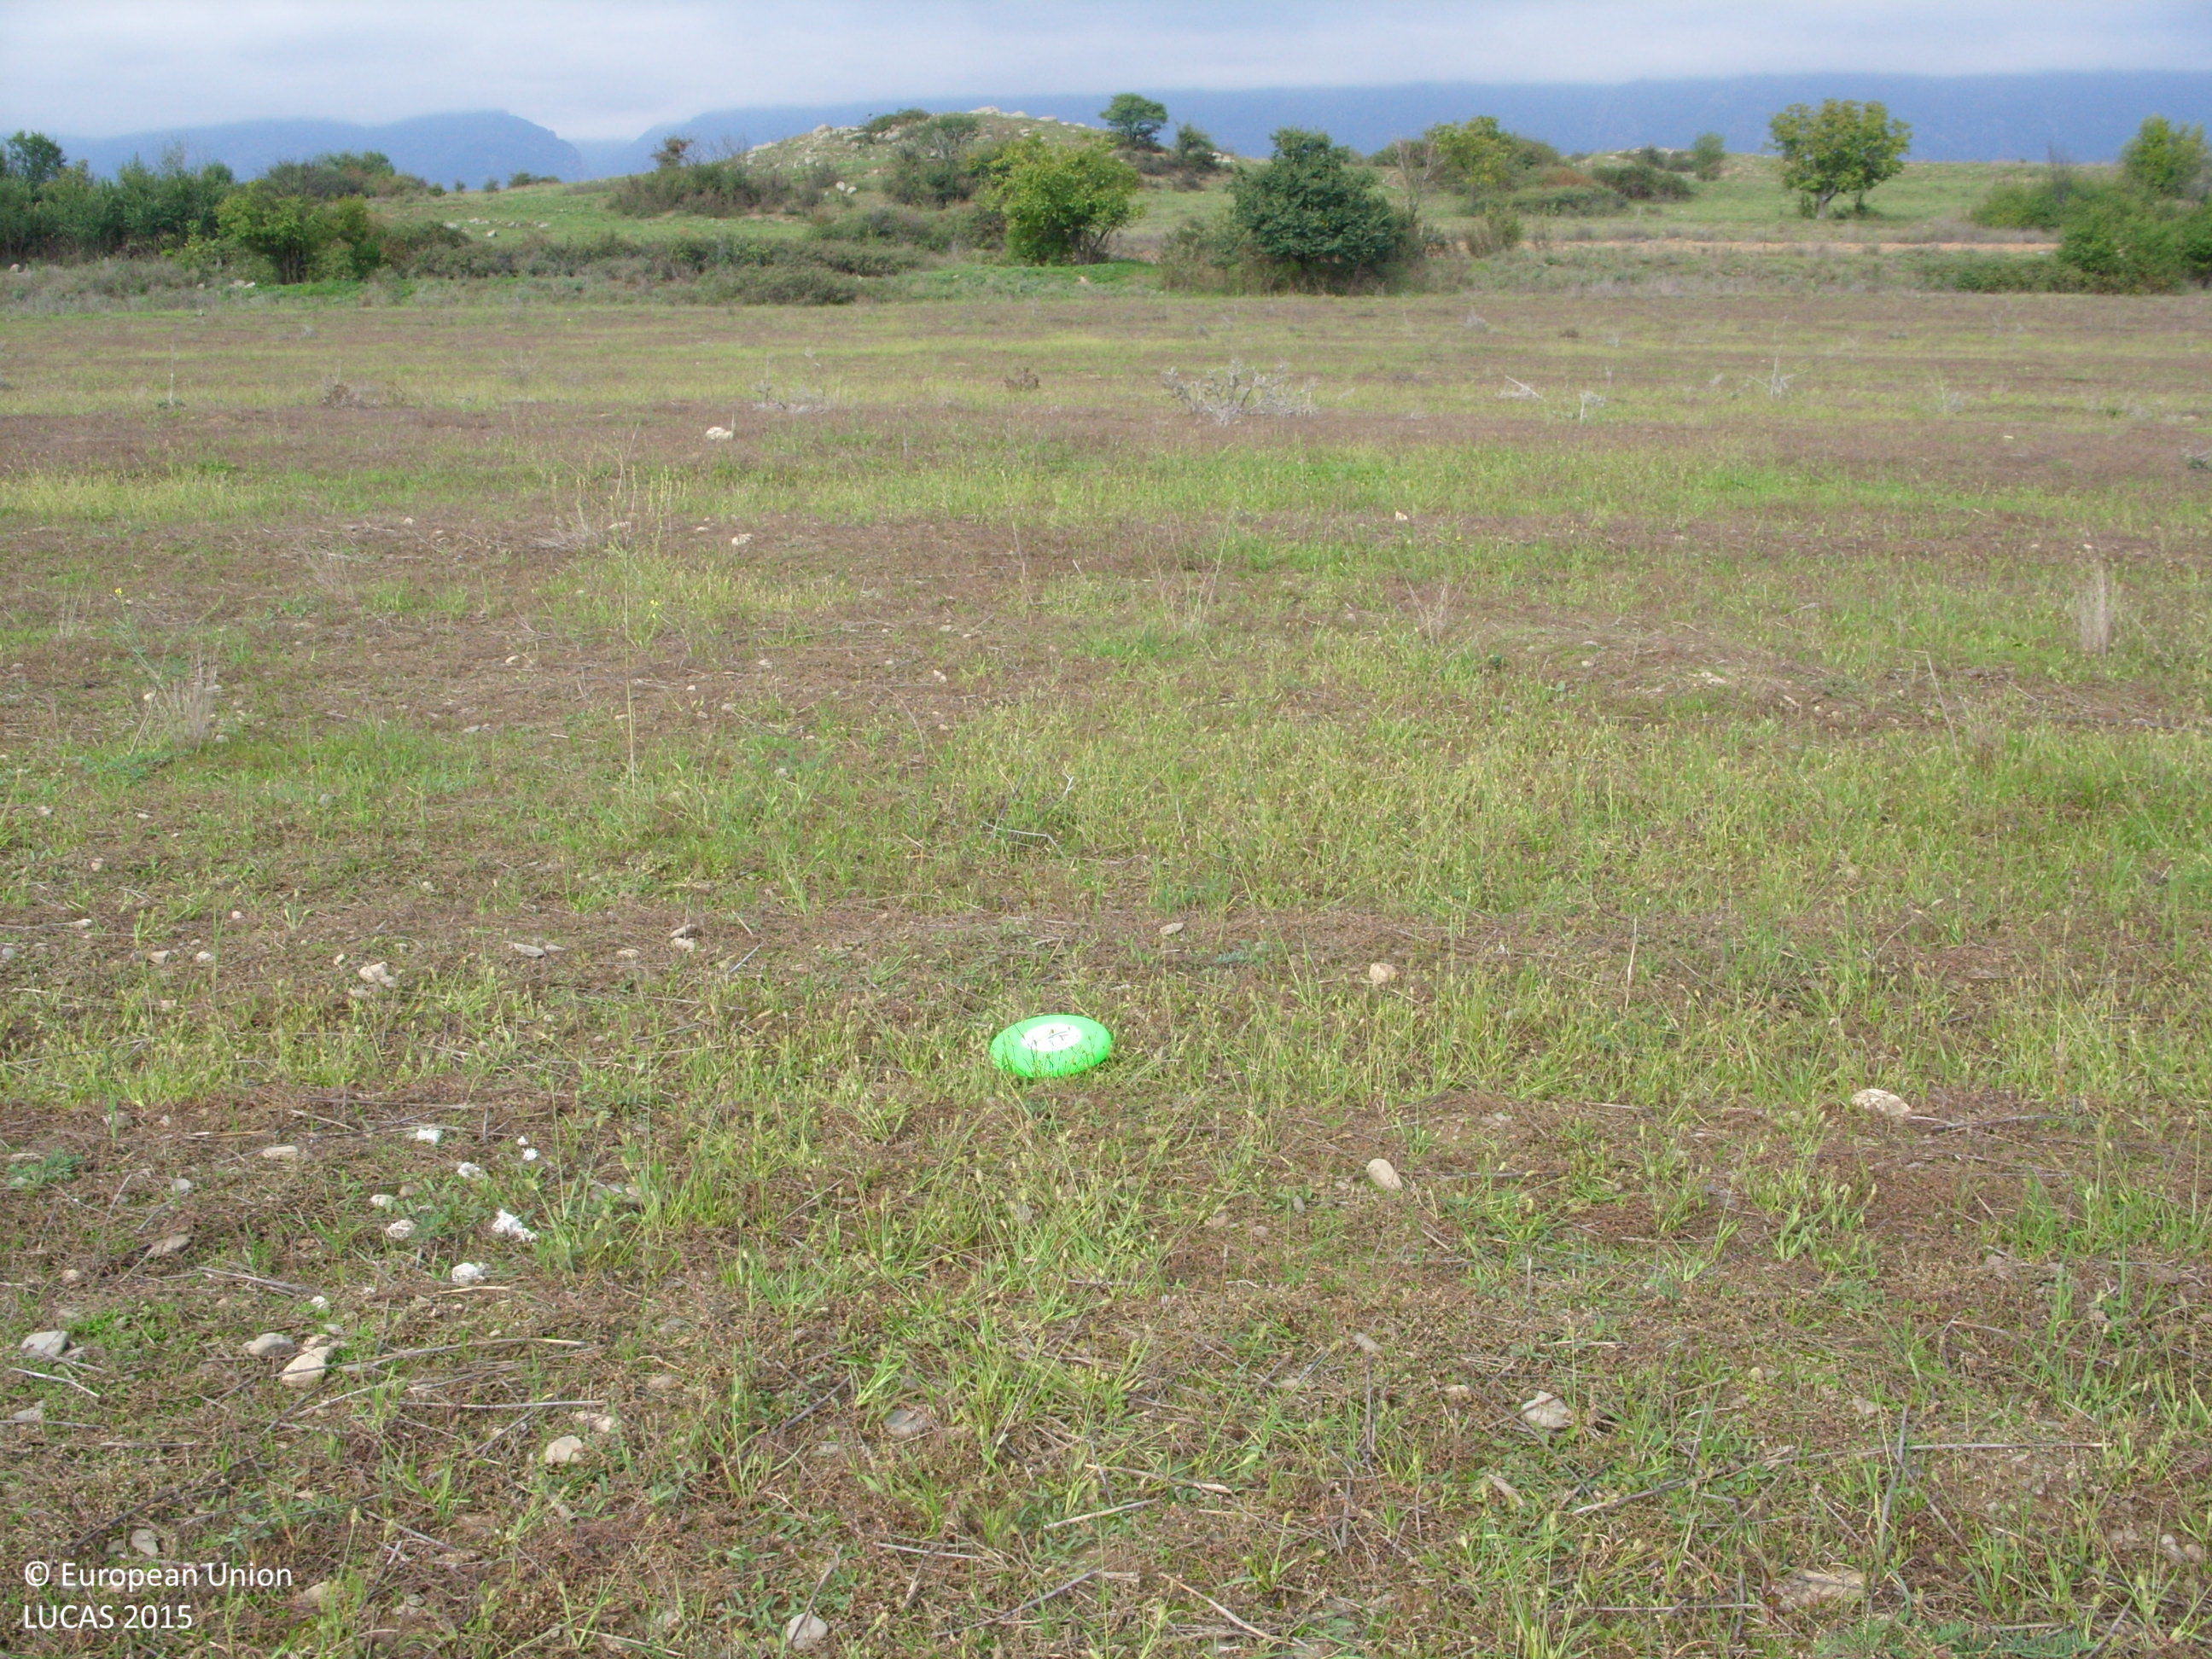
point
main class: Grassland
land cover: Spontaneously vegetated surfaces
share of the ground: > 75 %
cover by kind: herbaceous plants 90 %, unconsolidated bare surface 10 %
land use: Agriculture (excluding fallow land and kitchen gardens)
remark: Harvested field
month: October
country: BG
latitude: 42.5842
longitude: 24.8136
